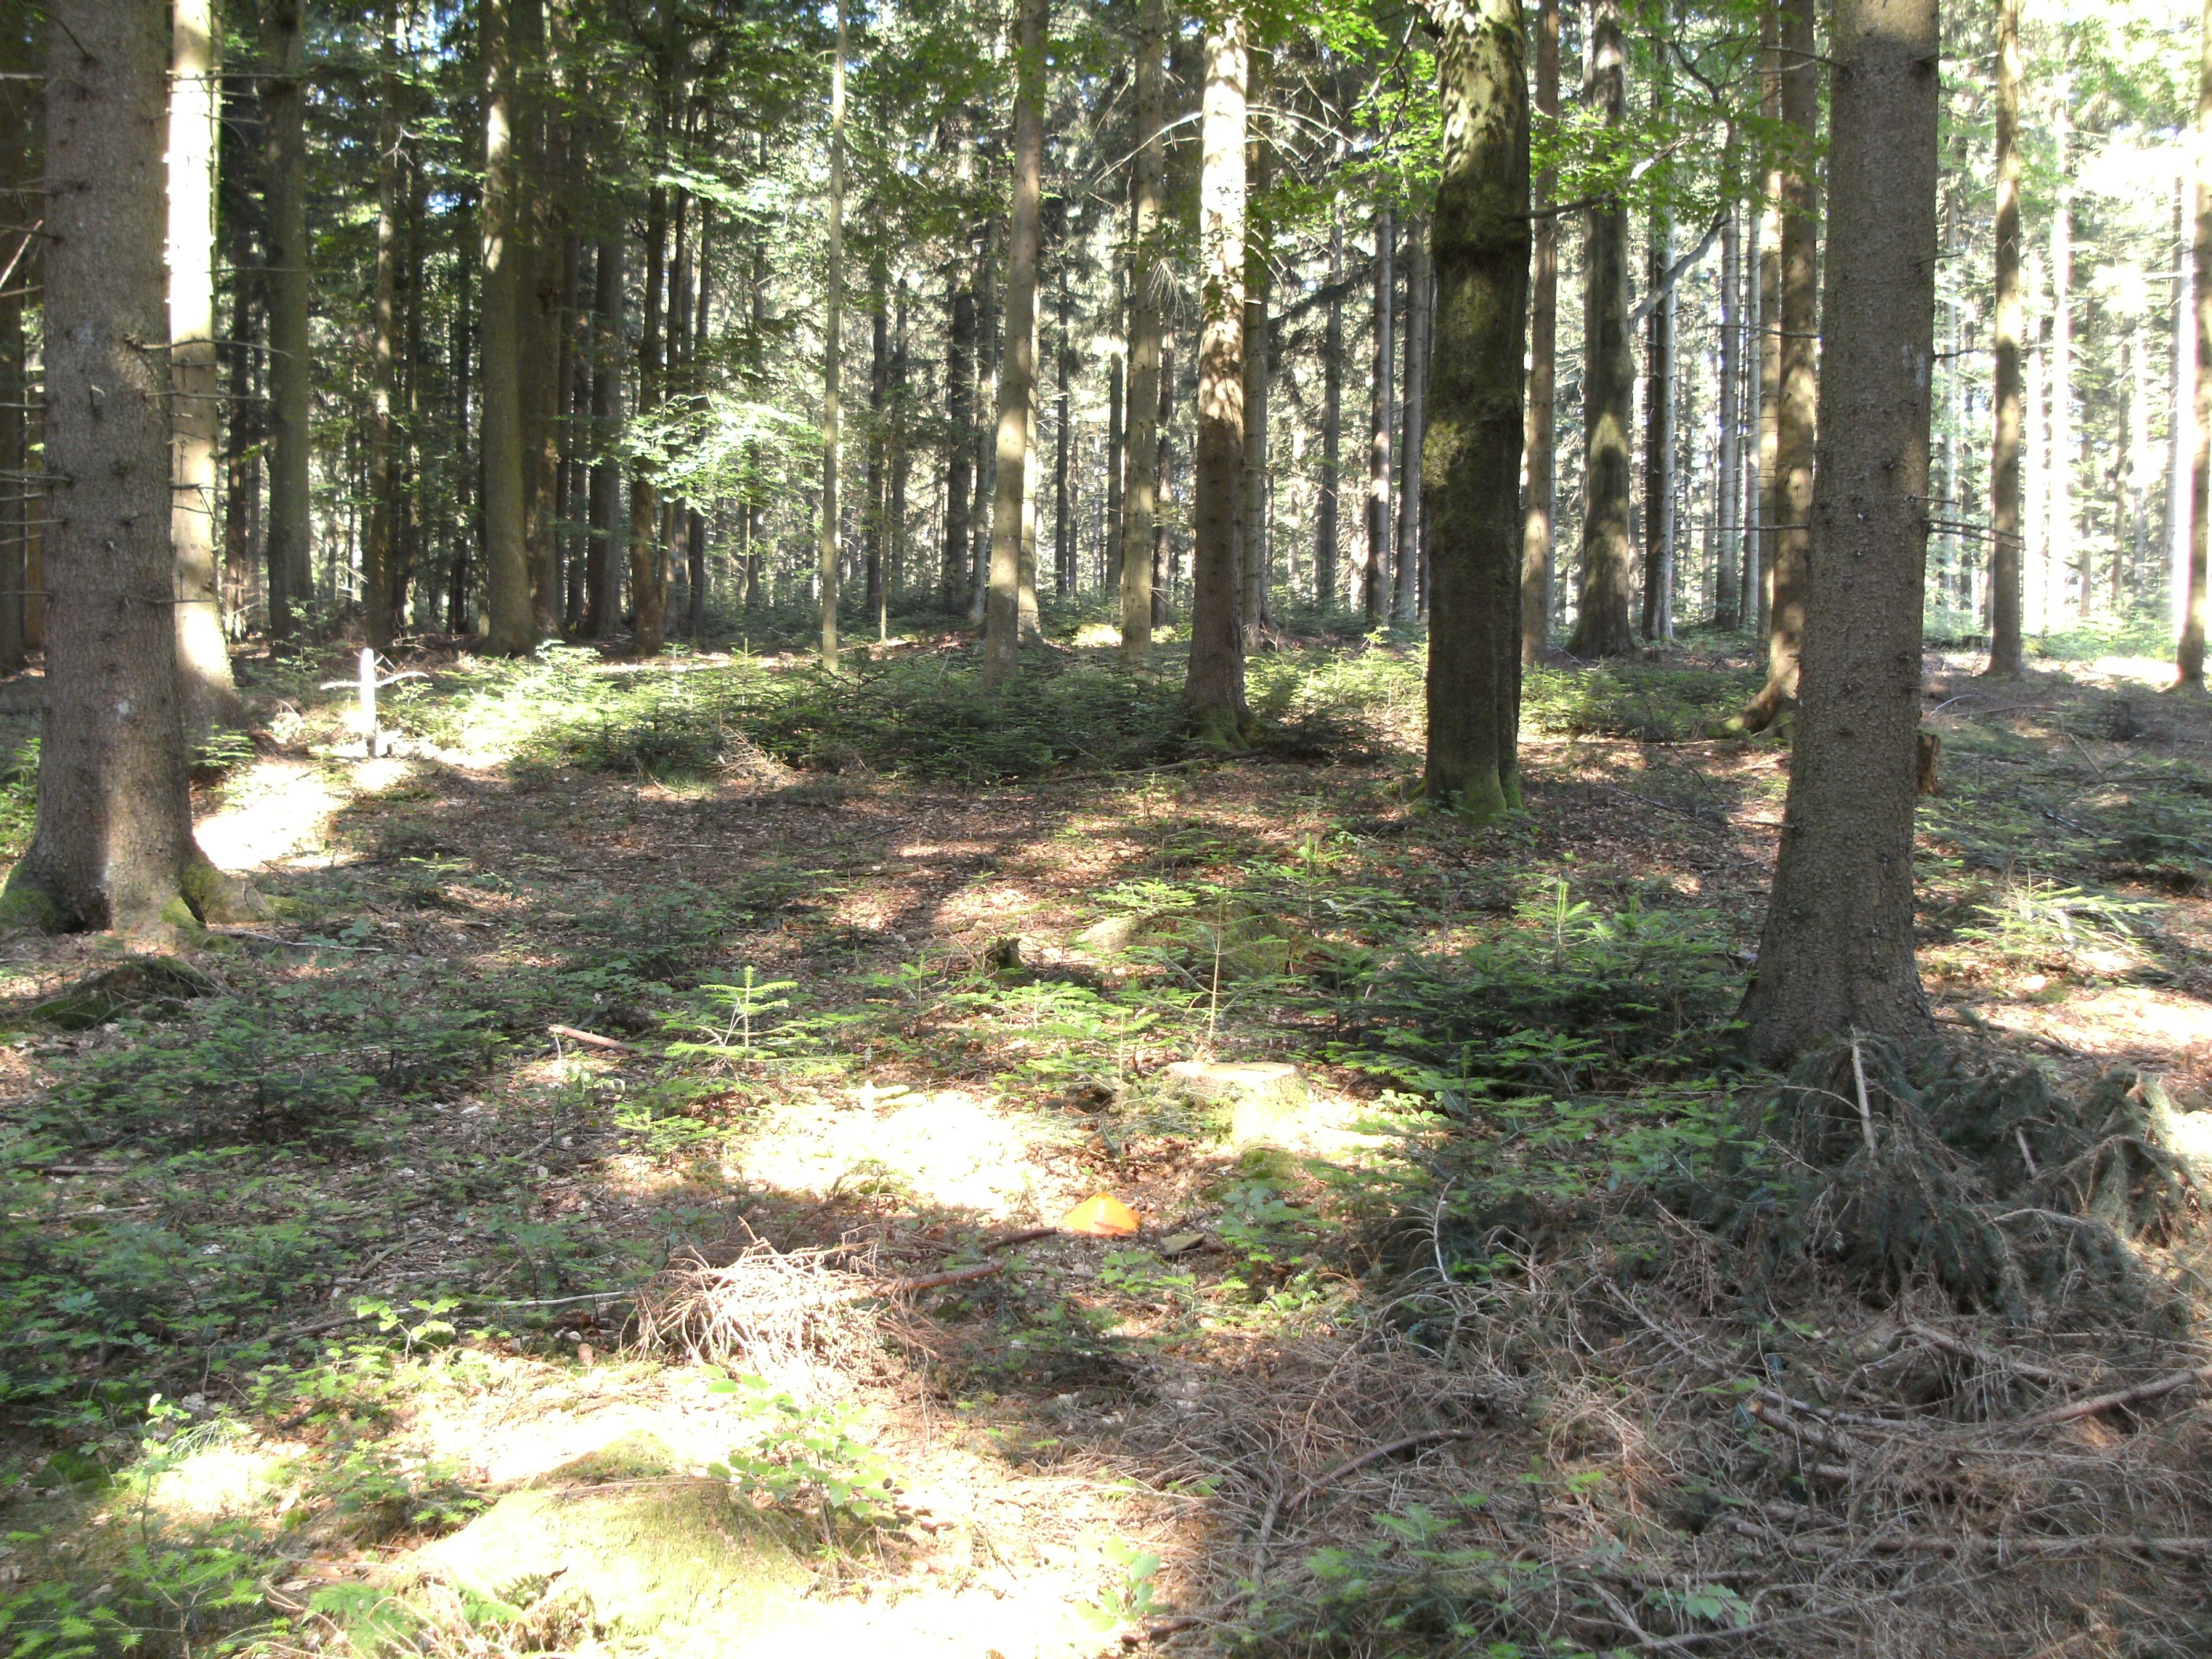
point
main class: Woodland
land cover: Spruce dominated coniferous woodland
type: hemiboreal forest and nemoral coniferous forest and mixed broadleaved-coniferous forest
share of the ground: > 75 %
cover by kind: coniferous forest trees 80 %, broadleaved forest trees 10 %, unconsolidated bare surface 10 %
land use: Forestry
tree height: > 5 m
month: June
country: AT
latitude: 48.0812
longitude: 13.3952
